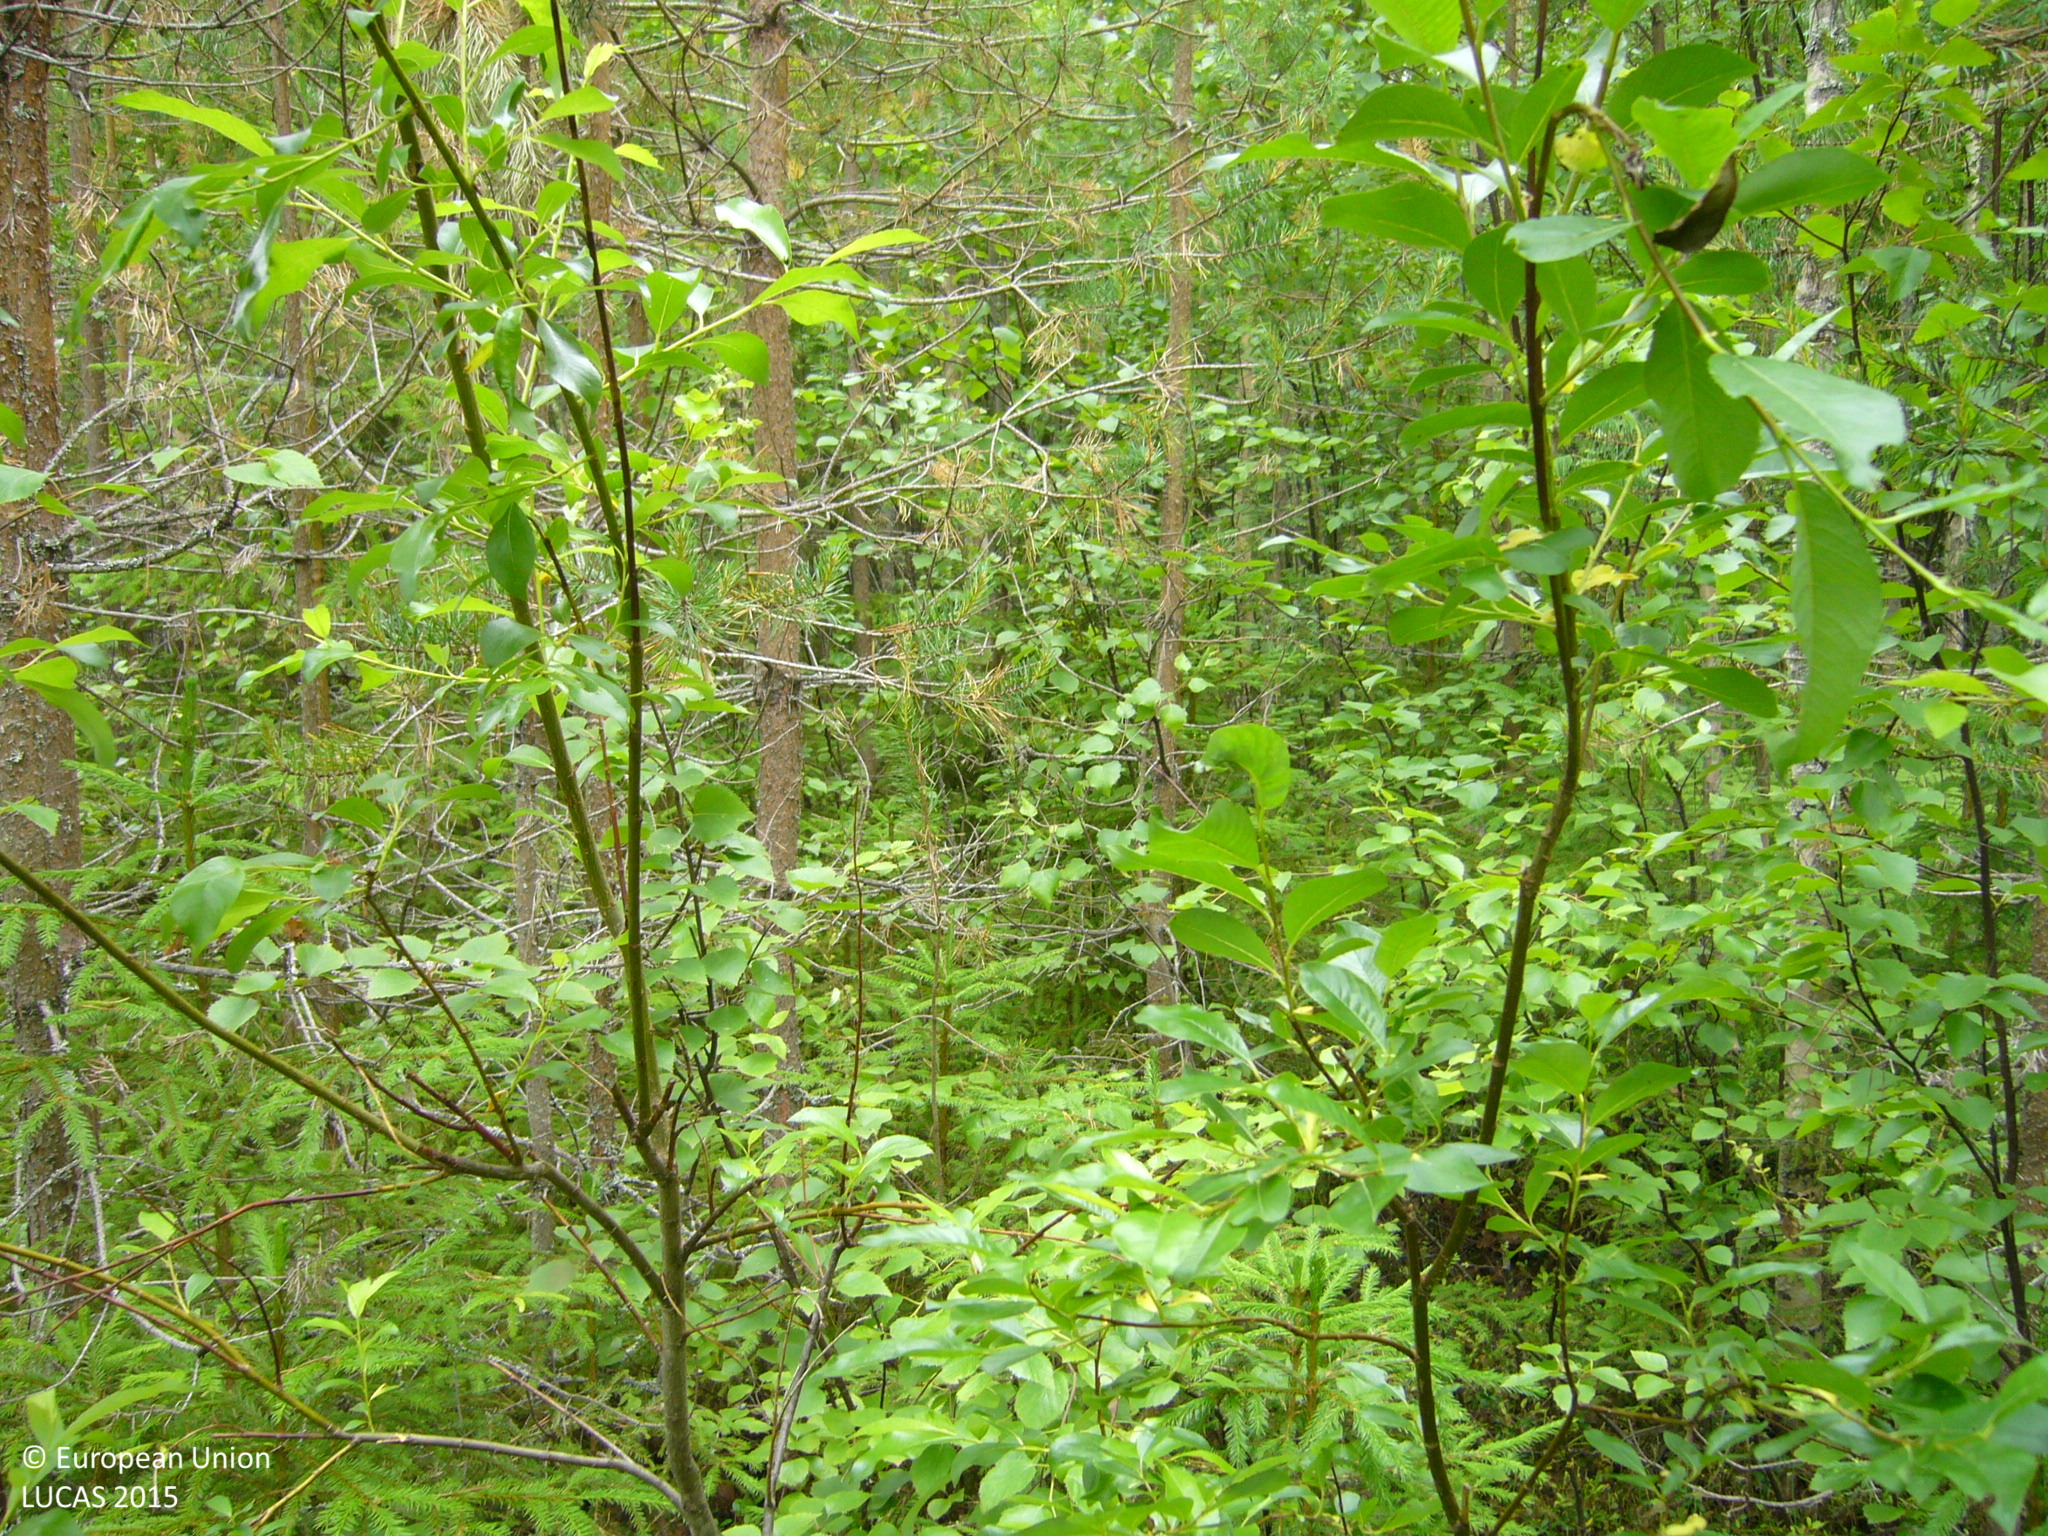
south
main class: Woodland
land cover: Pine dominated mixed woodland
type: boreal forest
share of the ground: > 75 %
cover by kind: coniferous forest trees 50 %, broadleaved forest trees 40 %, shrubs 10 %
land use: Forestry
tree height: > 5 m
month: July
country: FI
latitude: 63.1872
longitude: 26.1977
